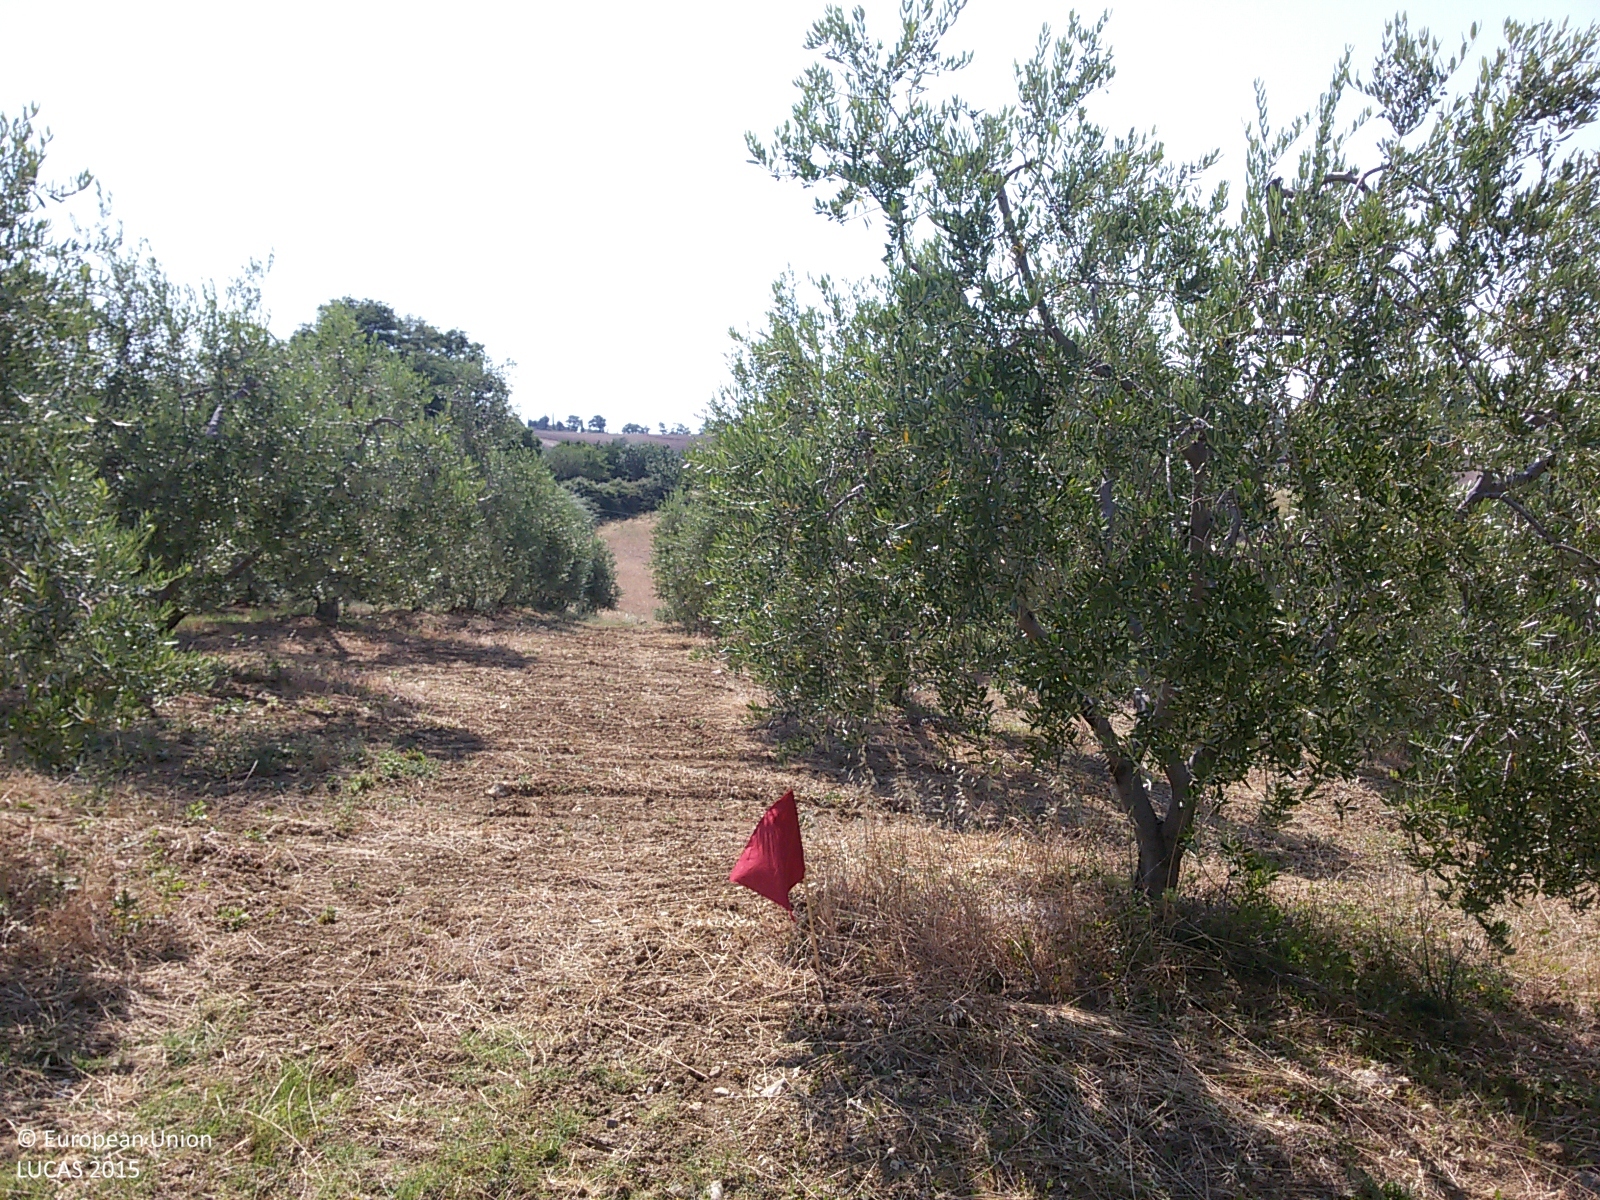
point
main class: Cropland
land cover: Olive groves
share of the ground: 25 - 50 %
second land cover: Other bare soil
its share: > 75 %
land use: Agriculture (excluding fallow land and kitchen gardens)
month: July
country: IT
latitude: 42.9142
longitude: 11.4776
